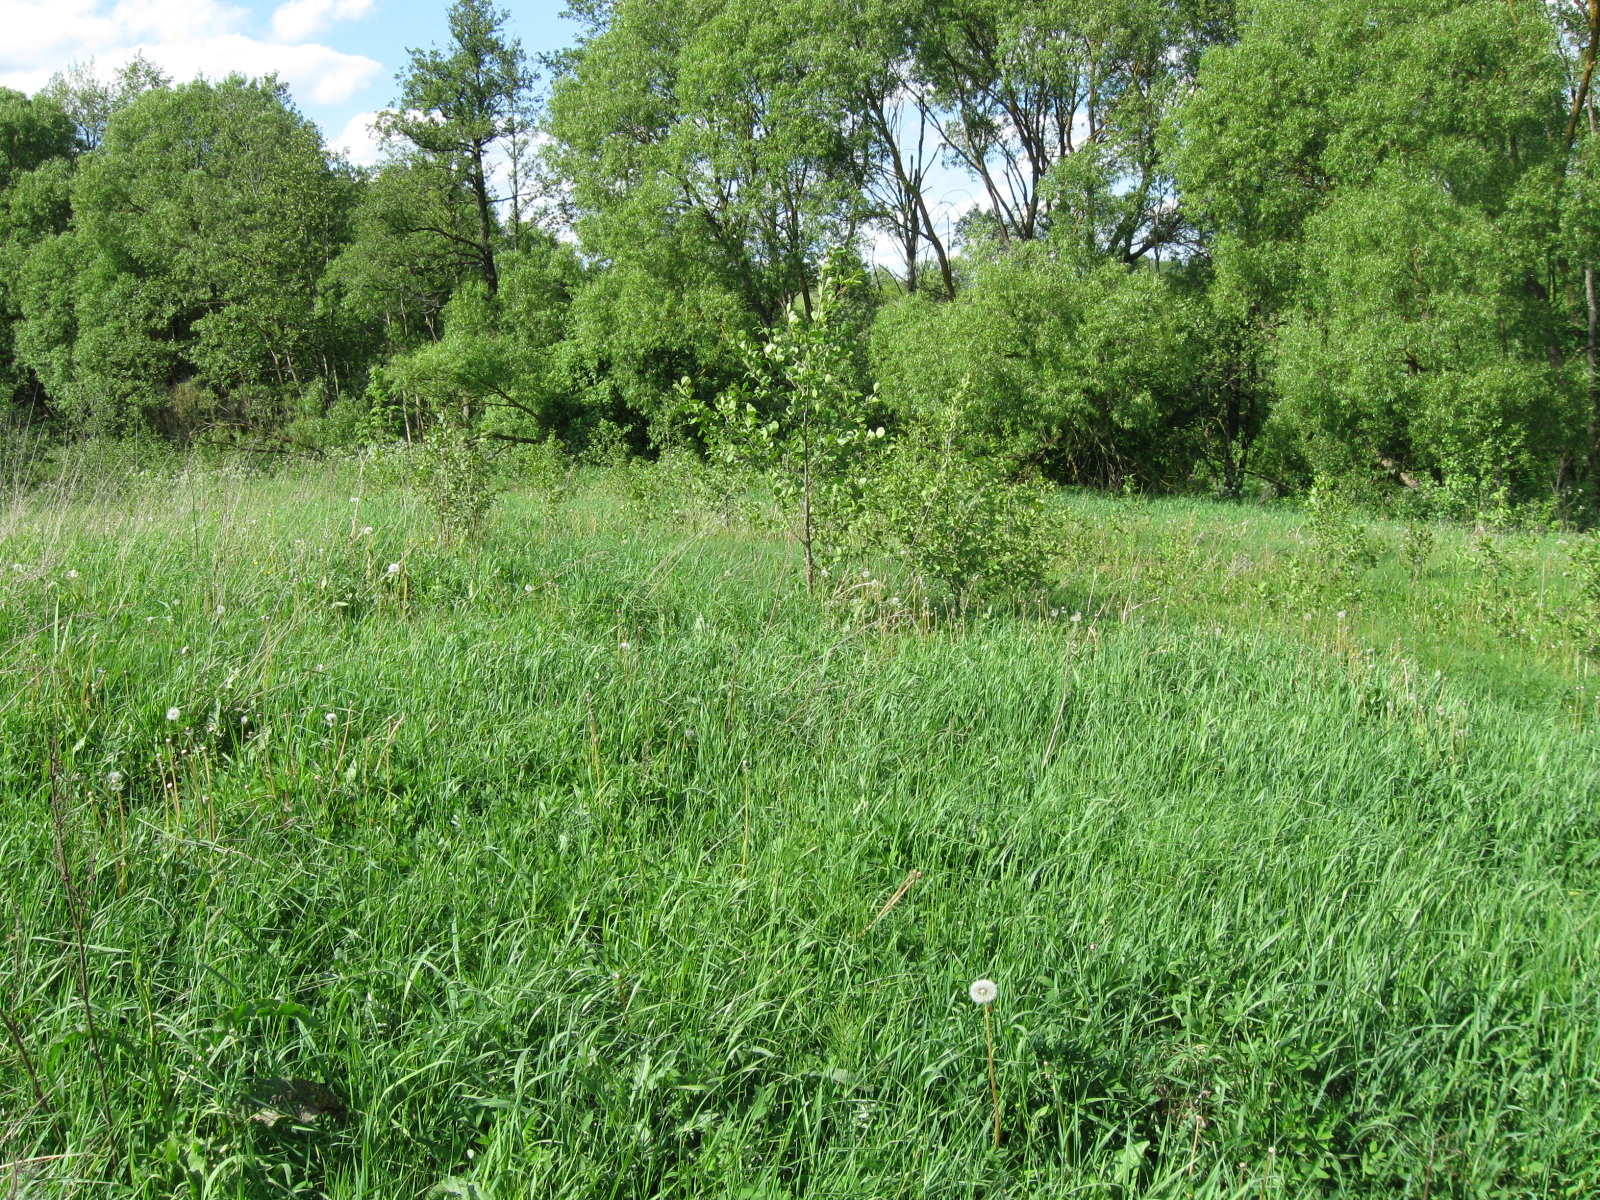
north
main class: Grassland
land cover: Grassland with sparse tree/shrub cover
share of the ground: > 75 %
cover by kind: herbaceous plants 95 %, broadleaved forest trees 5 %
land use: Abandoned areas
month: May
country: LT
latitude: 54.2415
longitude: 23.3840
